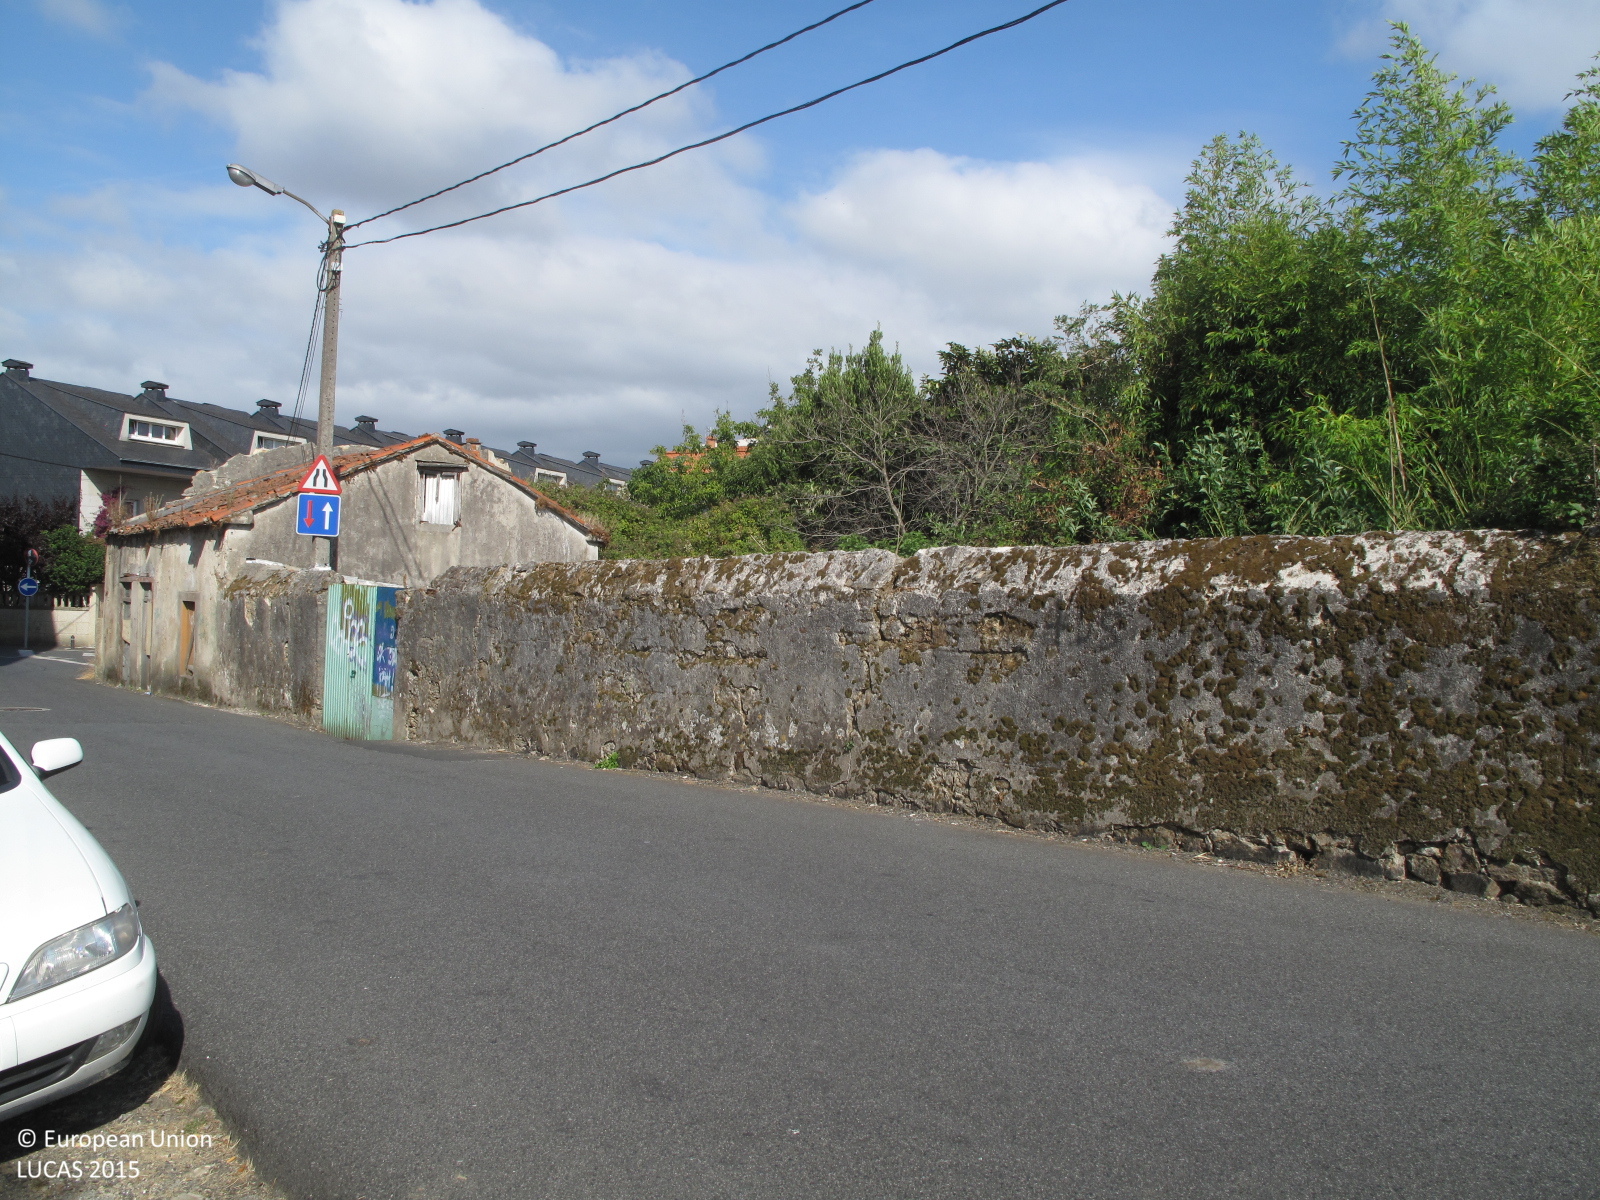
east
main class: Cropland
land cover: Apple fruit
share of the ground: 25 - 50 %
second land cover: Grassland without tree/shrub cover
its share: > 75 %
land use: Kitchen garden
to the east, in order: Apple fruit; Grassland without tree/shrub cover; Artificial constructions in urban areas
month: July
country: ES
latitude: 43.5002
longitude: -8.1957
